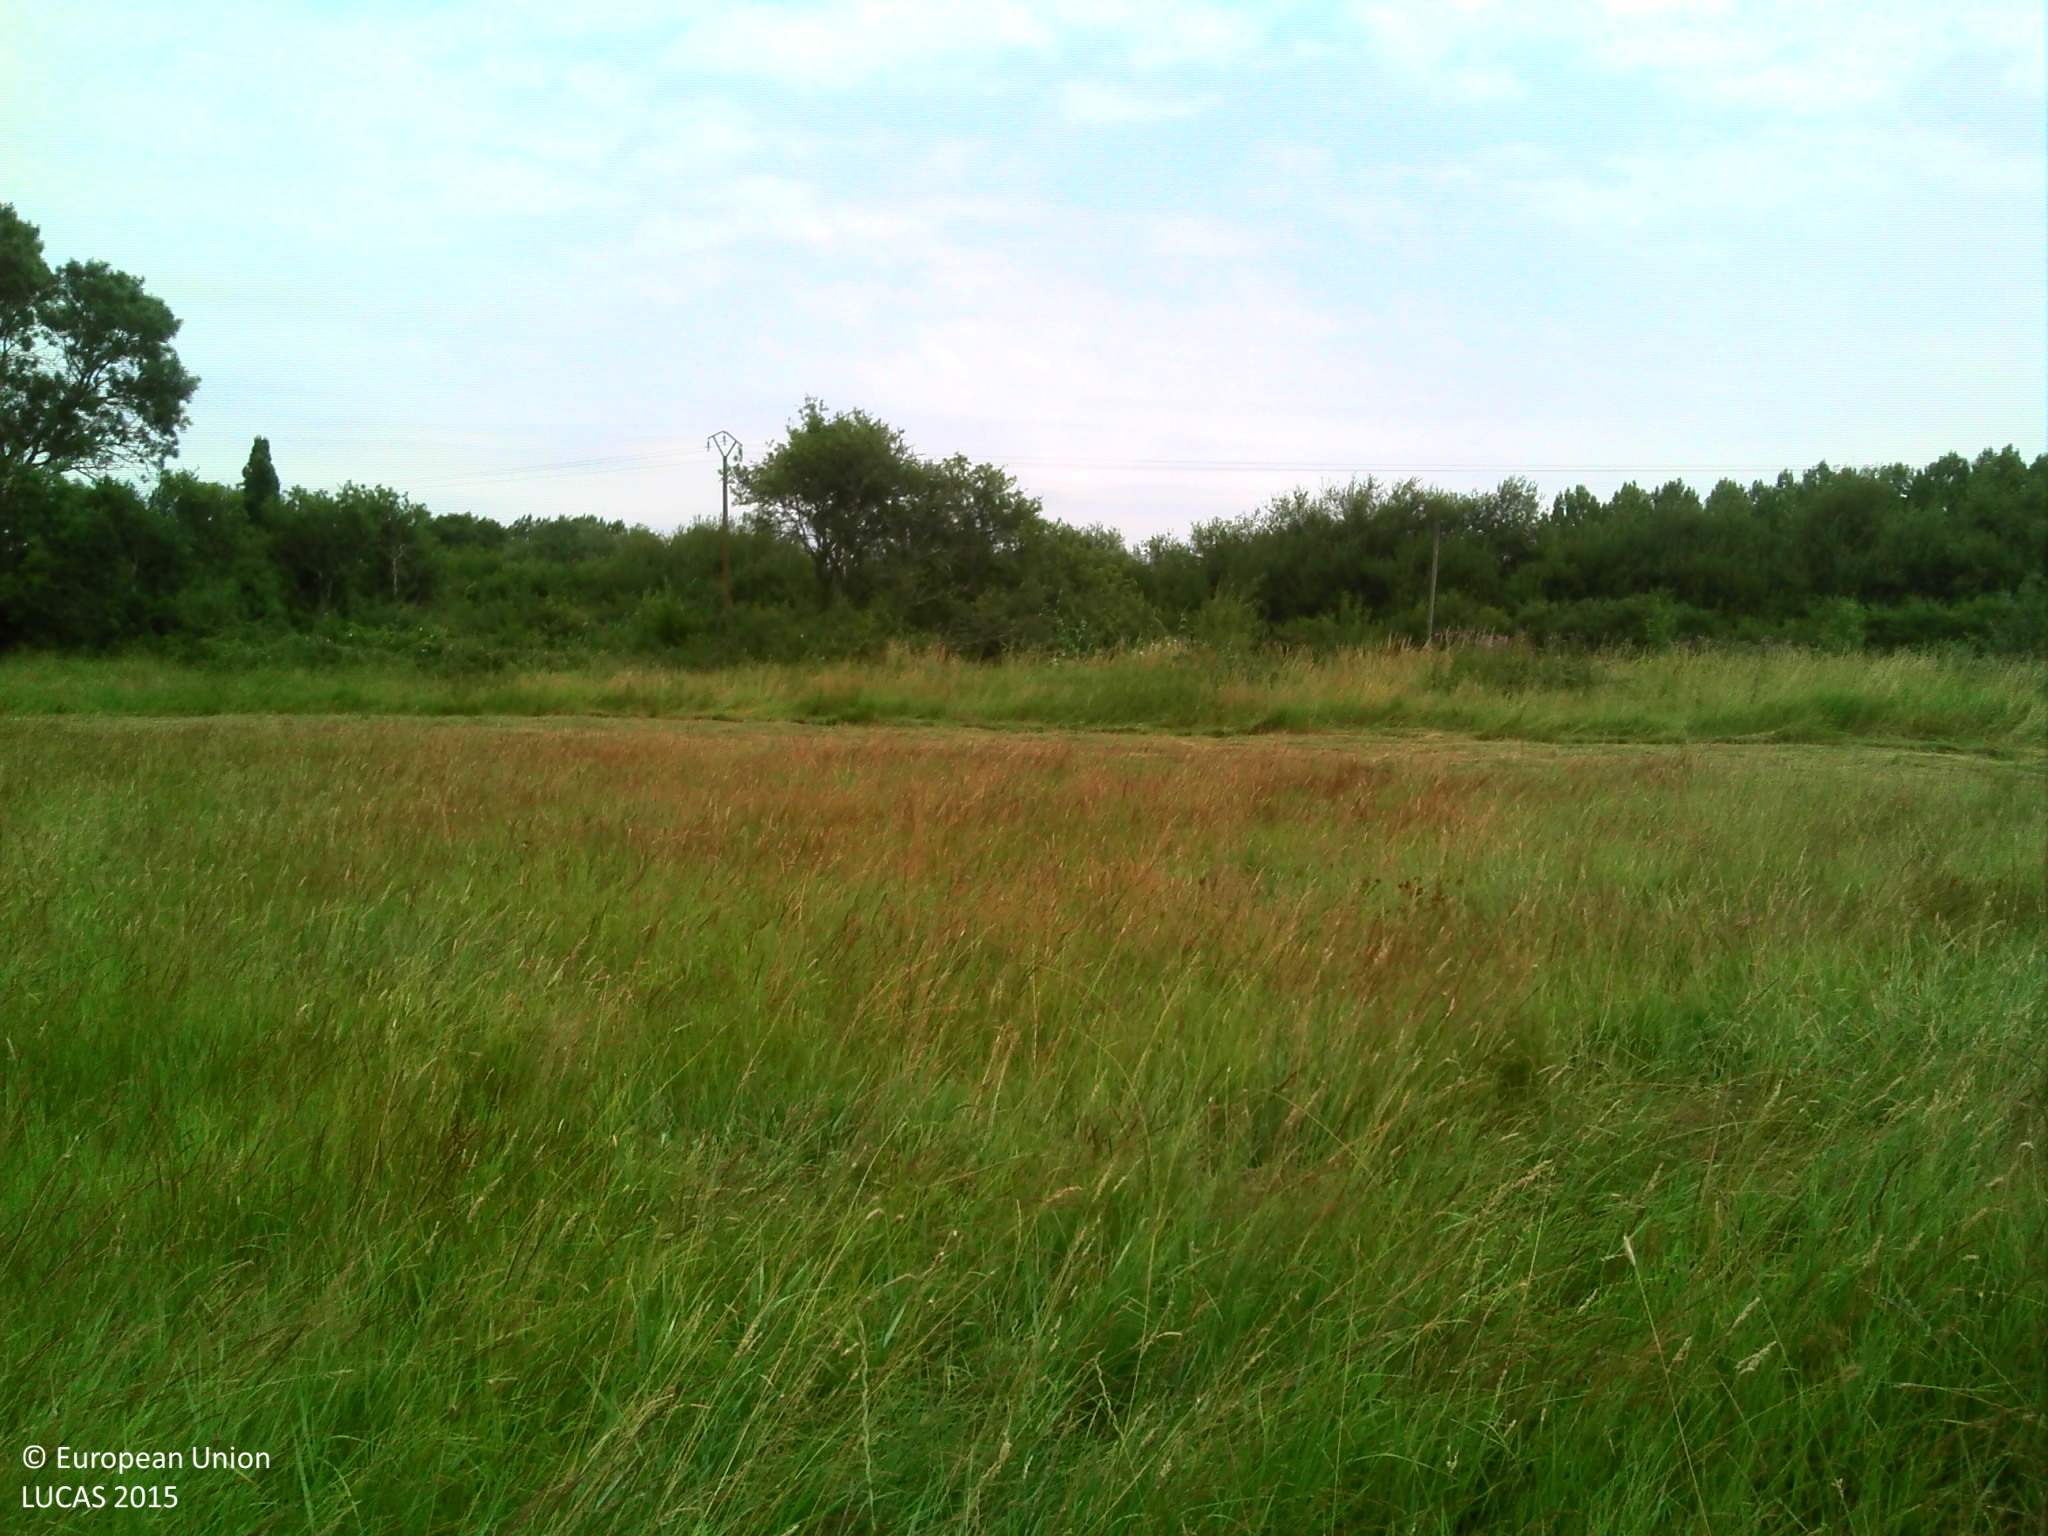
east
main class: Grassland
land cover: Grassland without tree/shrub cover
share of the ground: > 75 %
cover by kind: herbaceous plants 100 %
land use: Agriculture (excluding fallow land and kitchen gardens)
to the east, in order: Grassland without tree/shrub cover; Shrubland with sparse tree cover; Inland fresh running water; Spontaneously vegetated surfaces; Lines of trees; Electric lines; Grass margins; Paved roads, cycling and walking lanes; Grass margins; Electric lines; Shrubland with sparse tree cover; Grassland without tree/shrub cover
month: July
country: FR
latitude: 47.2343
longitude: -1.8683
